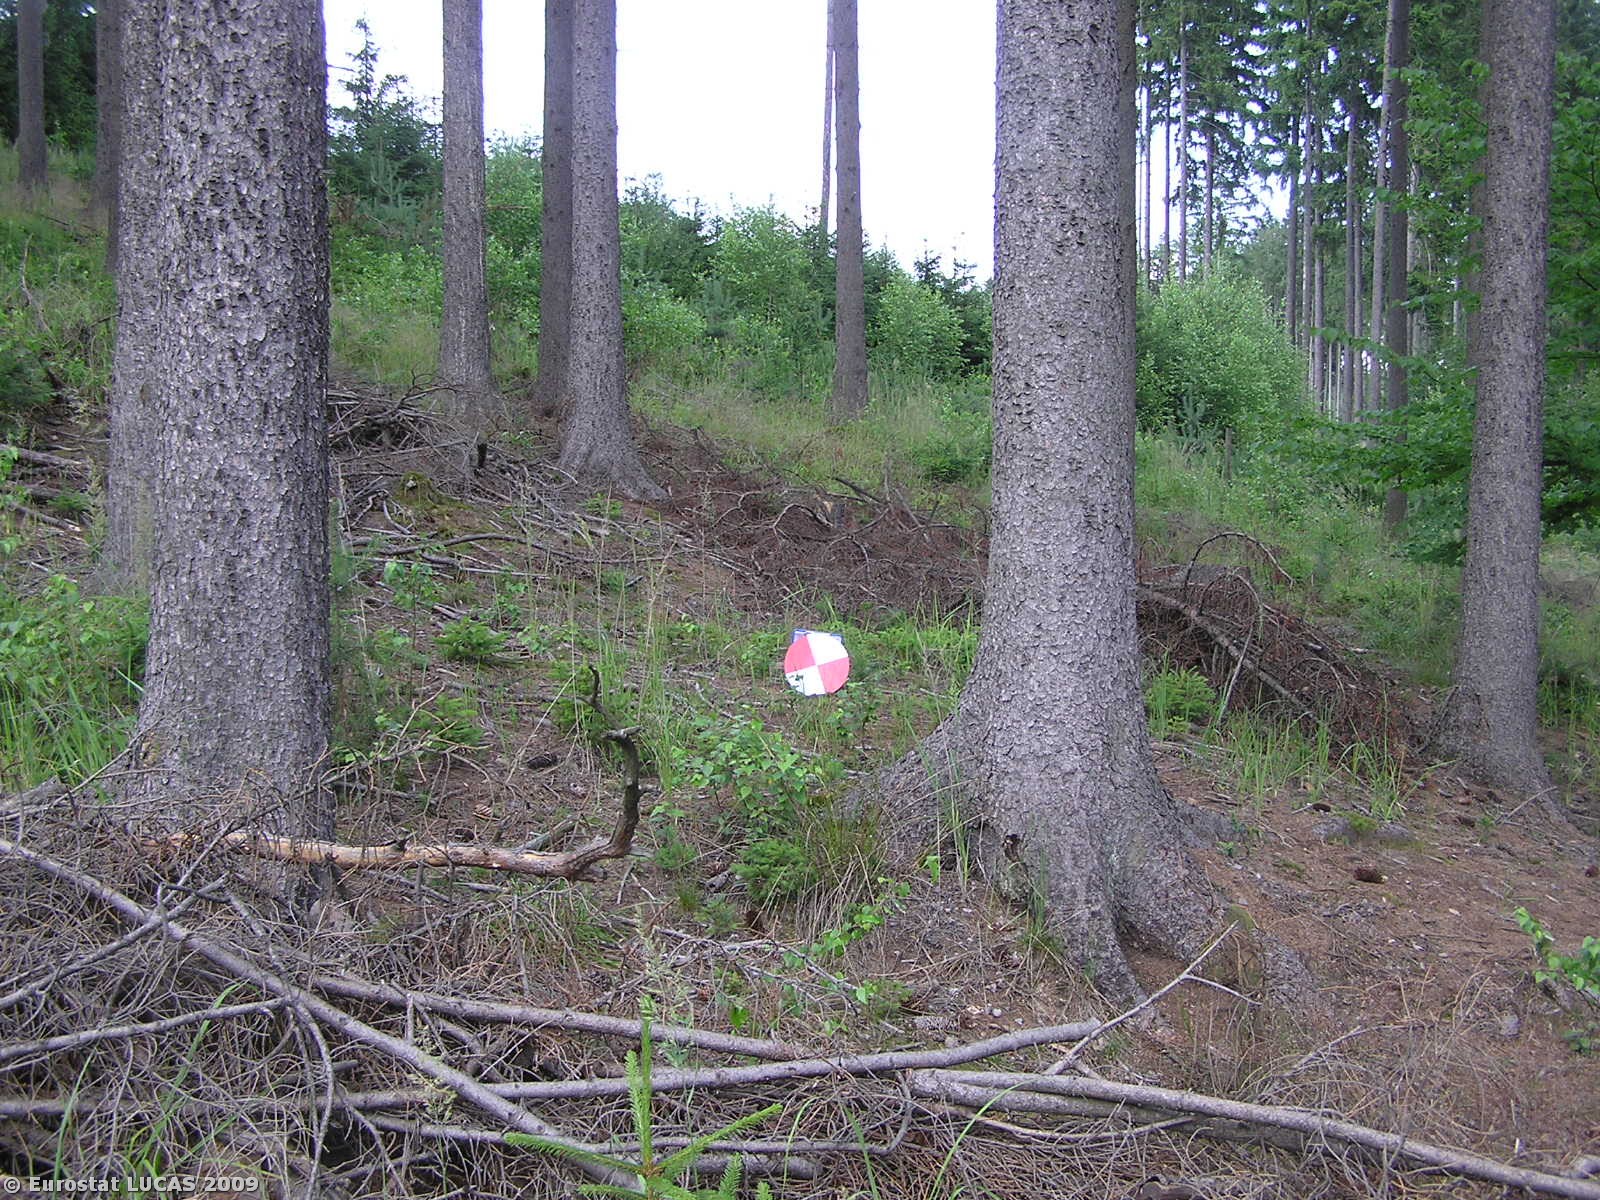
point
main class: Woodland
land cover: Coniferous woodland
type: hemiboreal forest and nemoral coniferous forest and mixed broadleaved-coniferous forest
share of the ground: > 75 %
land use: Forestry
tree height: > 5 m
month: July
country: CZ
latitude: 50.3380
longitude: 17.1623
